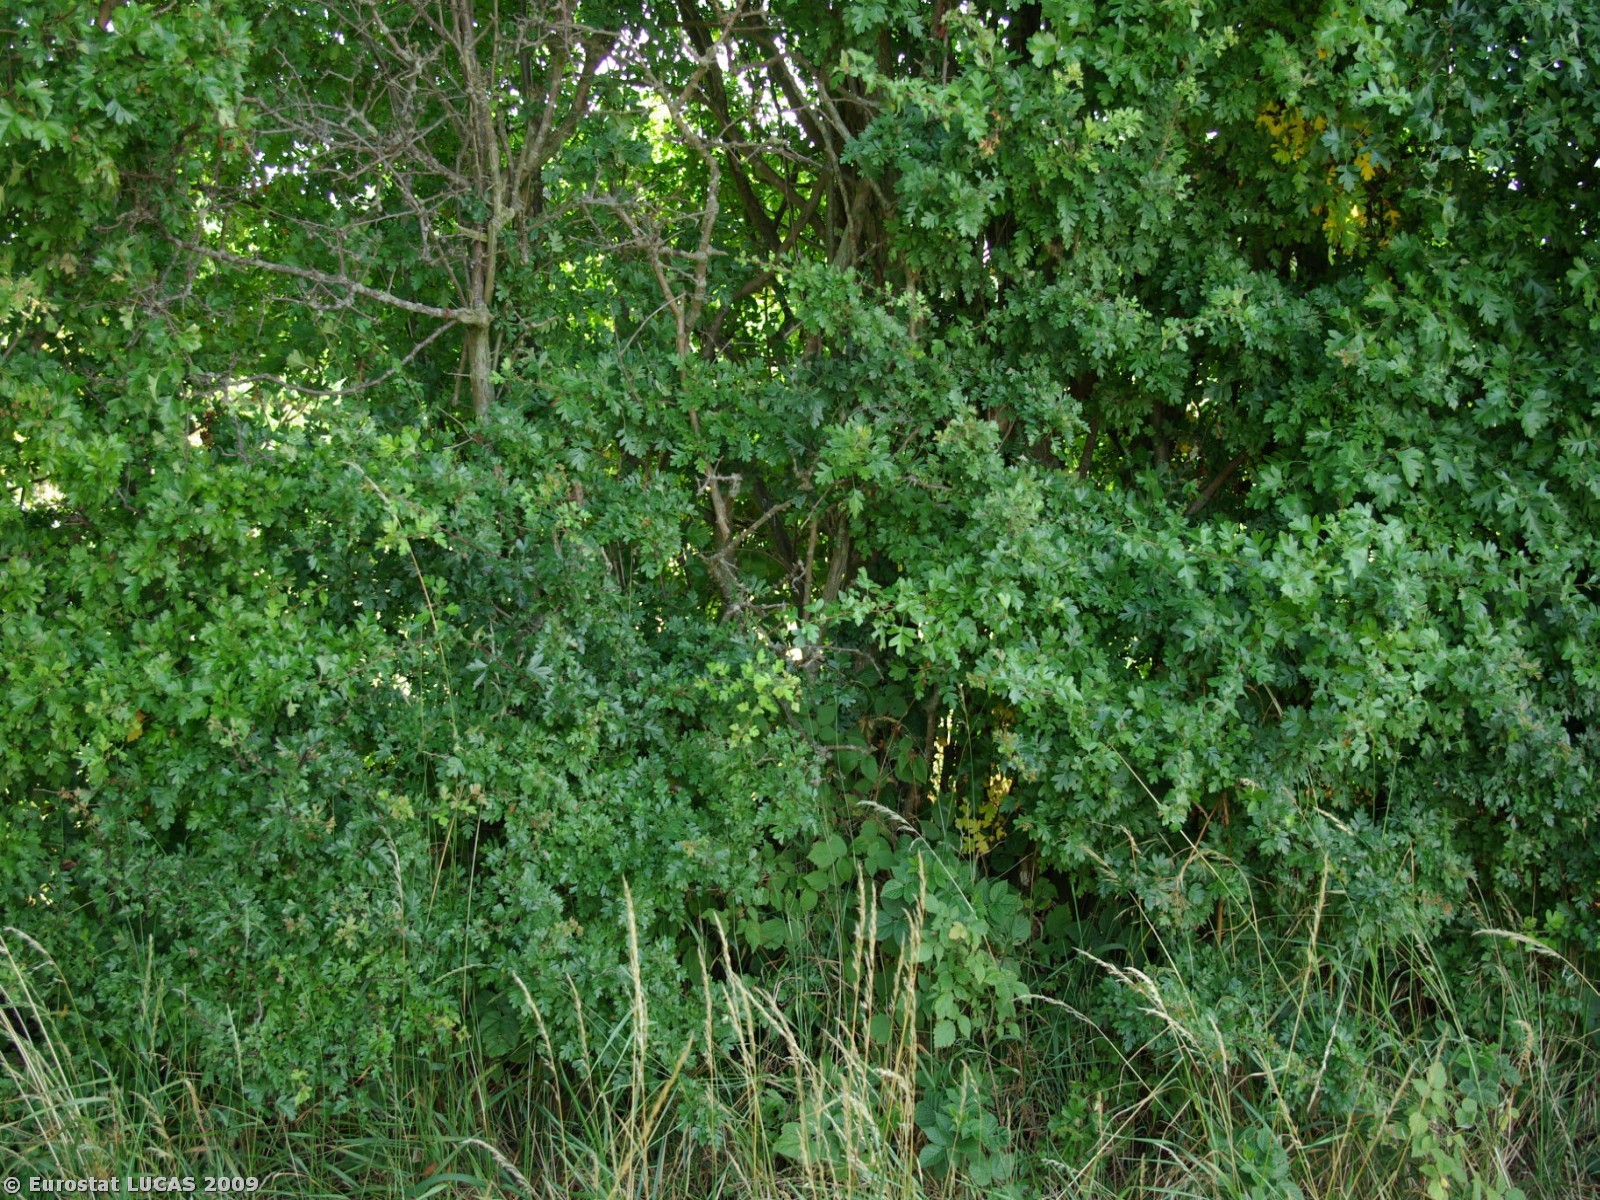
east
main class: Cropland
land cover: Common wheat
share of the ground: > 75 %
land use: Agriculture (excluding fallow land and kitchen gardens)
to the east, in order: Common wheat; Broadleaved woodland; Common wheat; Managed hedges; Grassland without tree/shrub cover; Managed hedges; Fences; Grass margins; Grassland without tree/shrub cover; Grass margins; Broadleaved woodland; Grass margins; Ditches and canals; Grass margins; Paved roads, cycling and walking lanes; Artificial constructions in urban areas
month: July
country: DK
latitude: 54.8756
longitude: 9.9221
